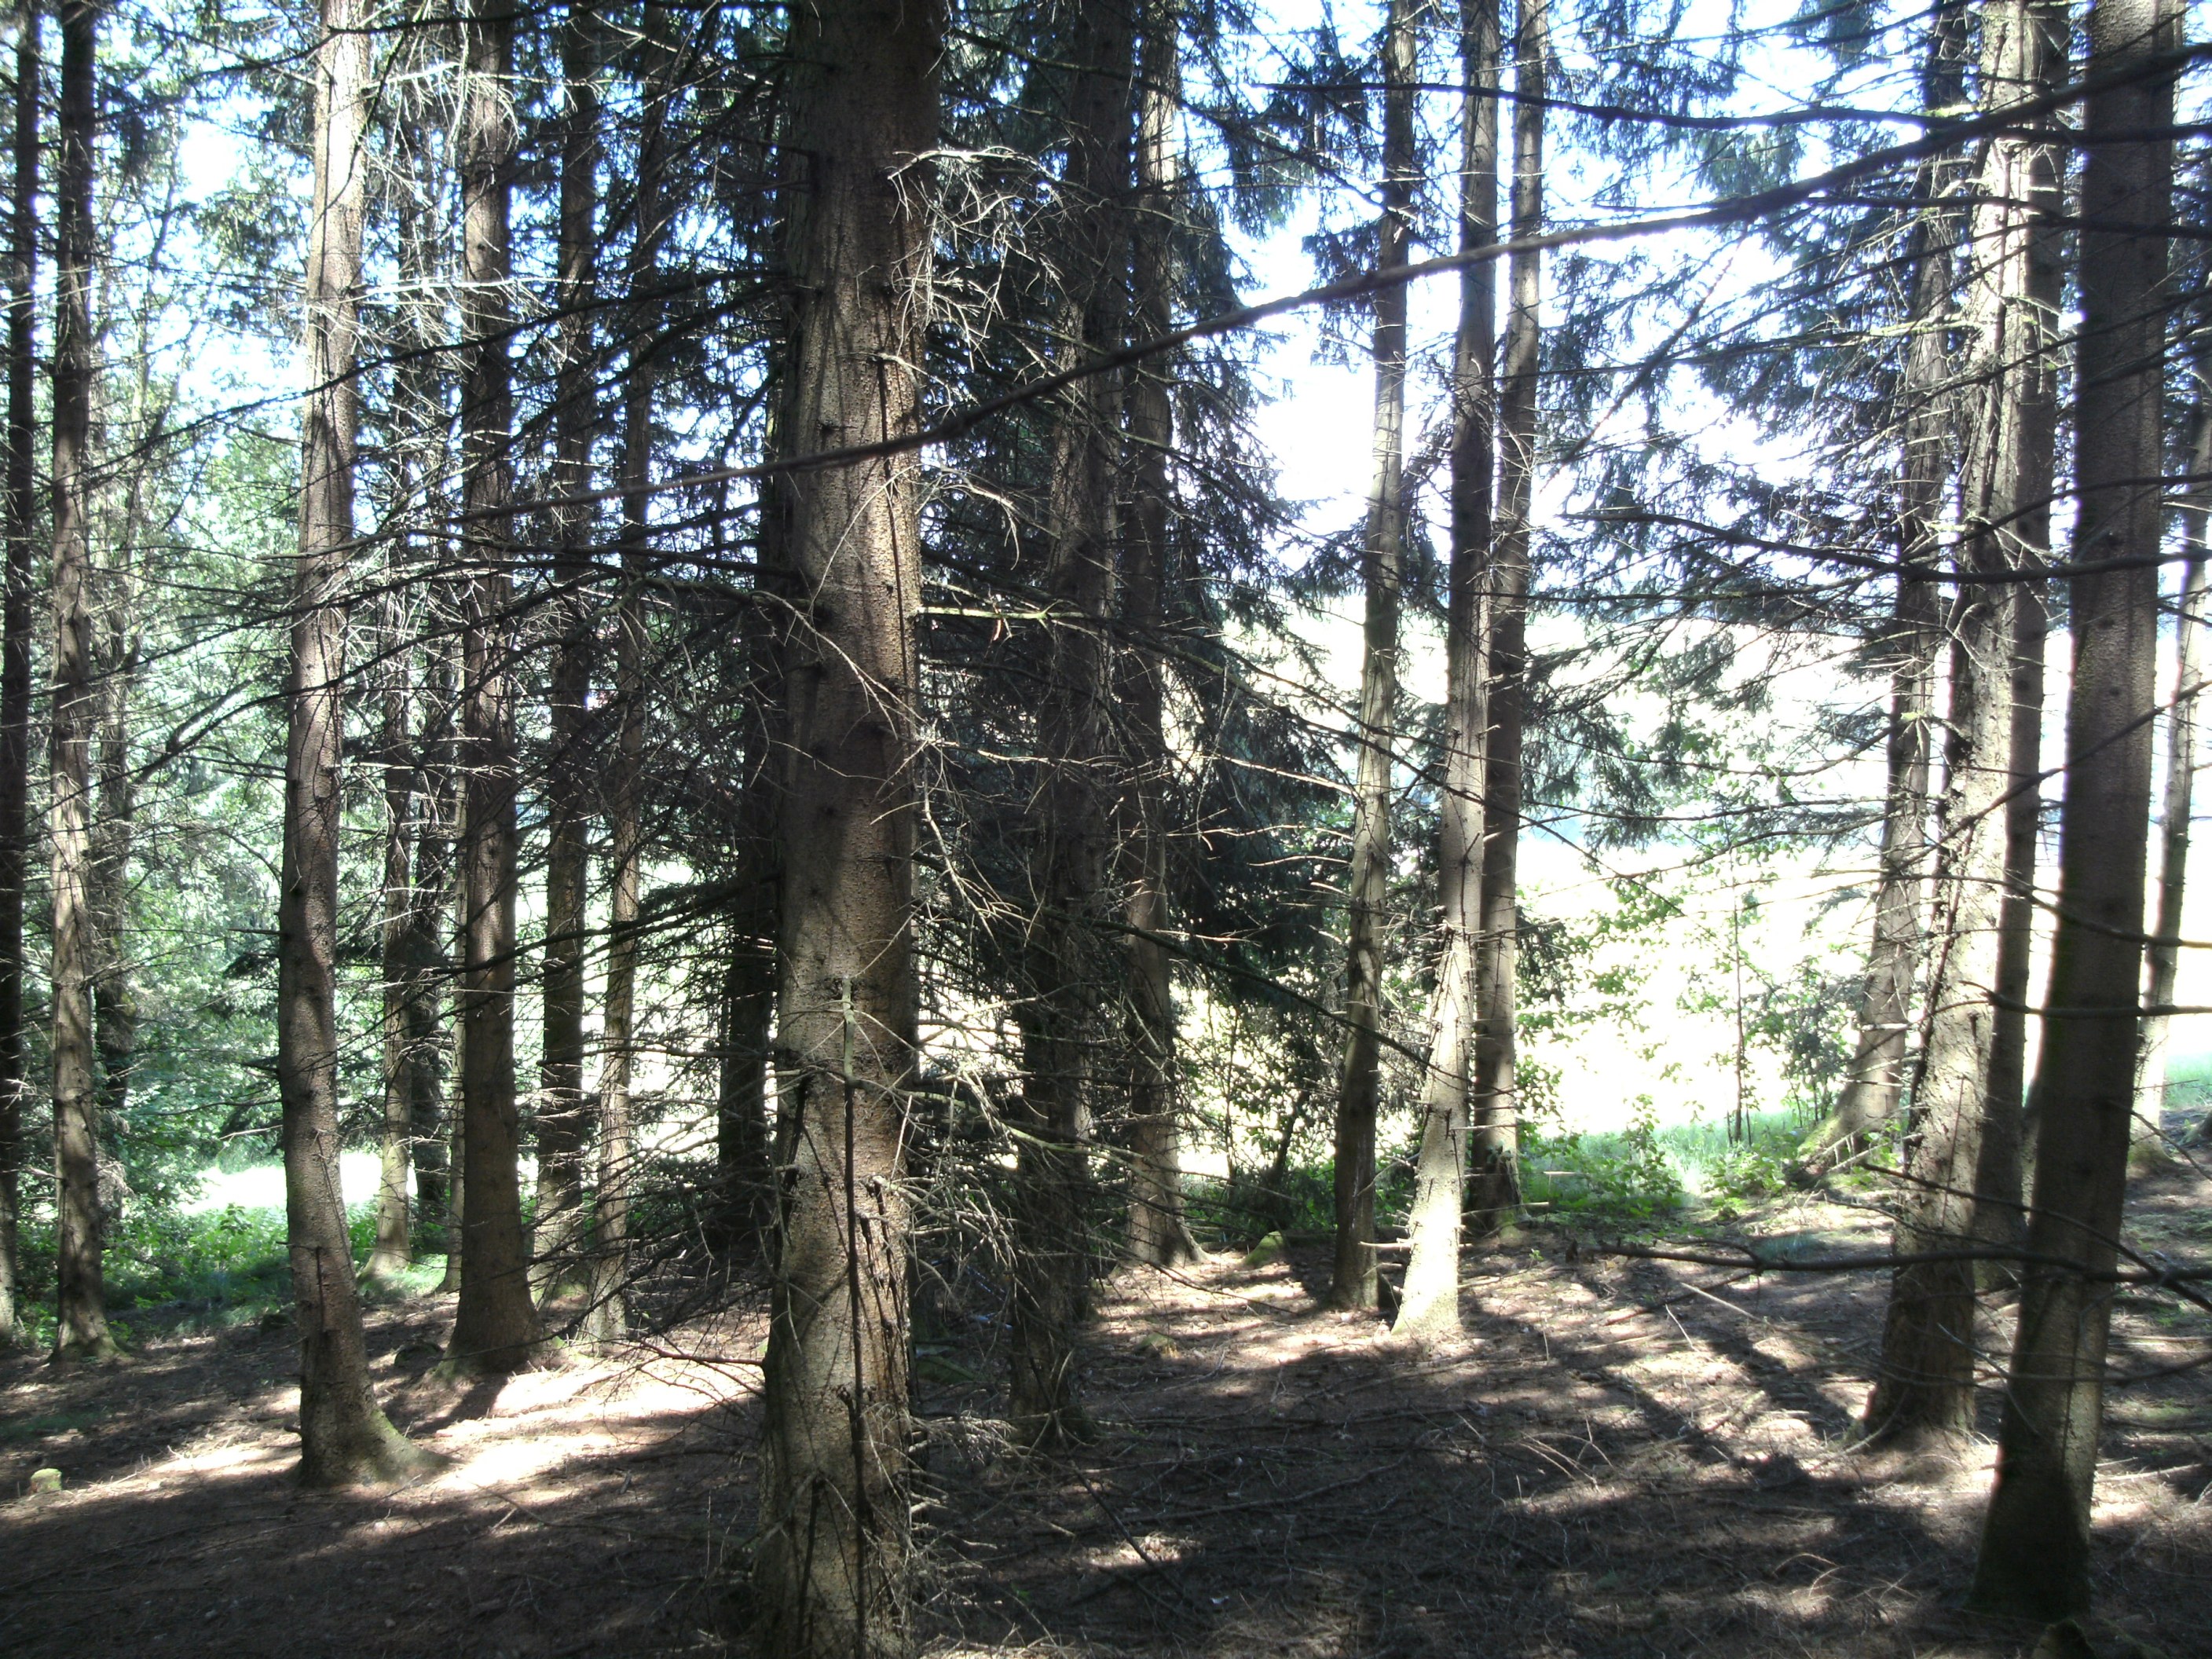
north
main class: Woodland
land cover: Spruce dominated coniferous woodland
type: hemiboreal forest and nemoral coniferous forest and mixed broadleaved-coniferous forest
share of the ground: > 75 %
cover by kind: coniferous forest trees 90 %, unconsolidated bare surface 10 %
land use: Forestry
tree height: > 5 m
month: June
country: AT
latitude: 48.1759
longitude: 13.8053
